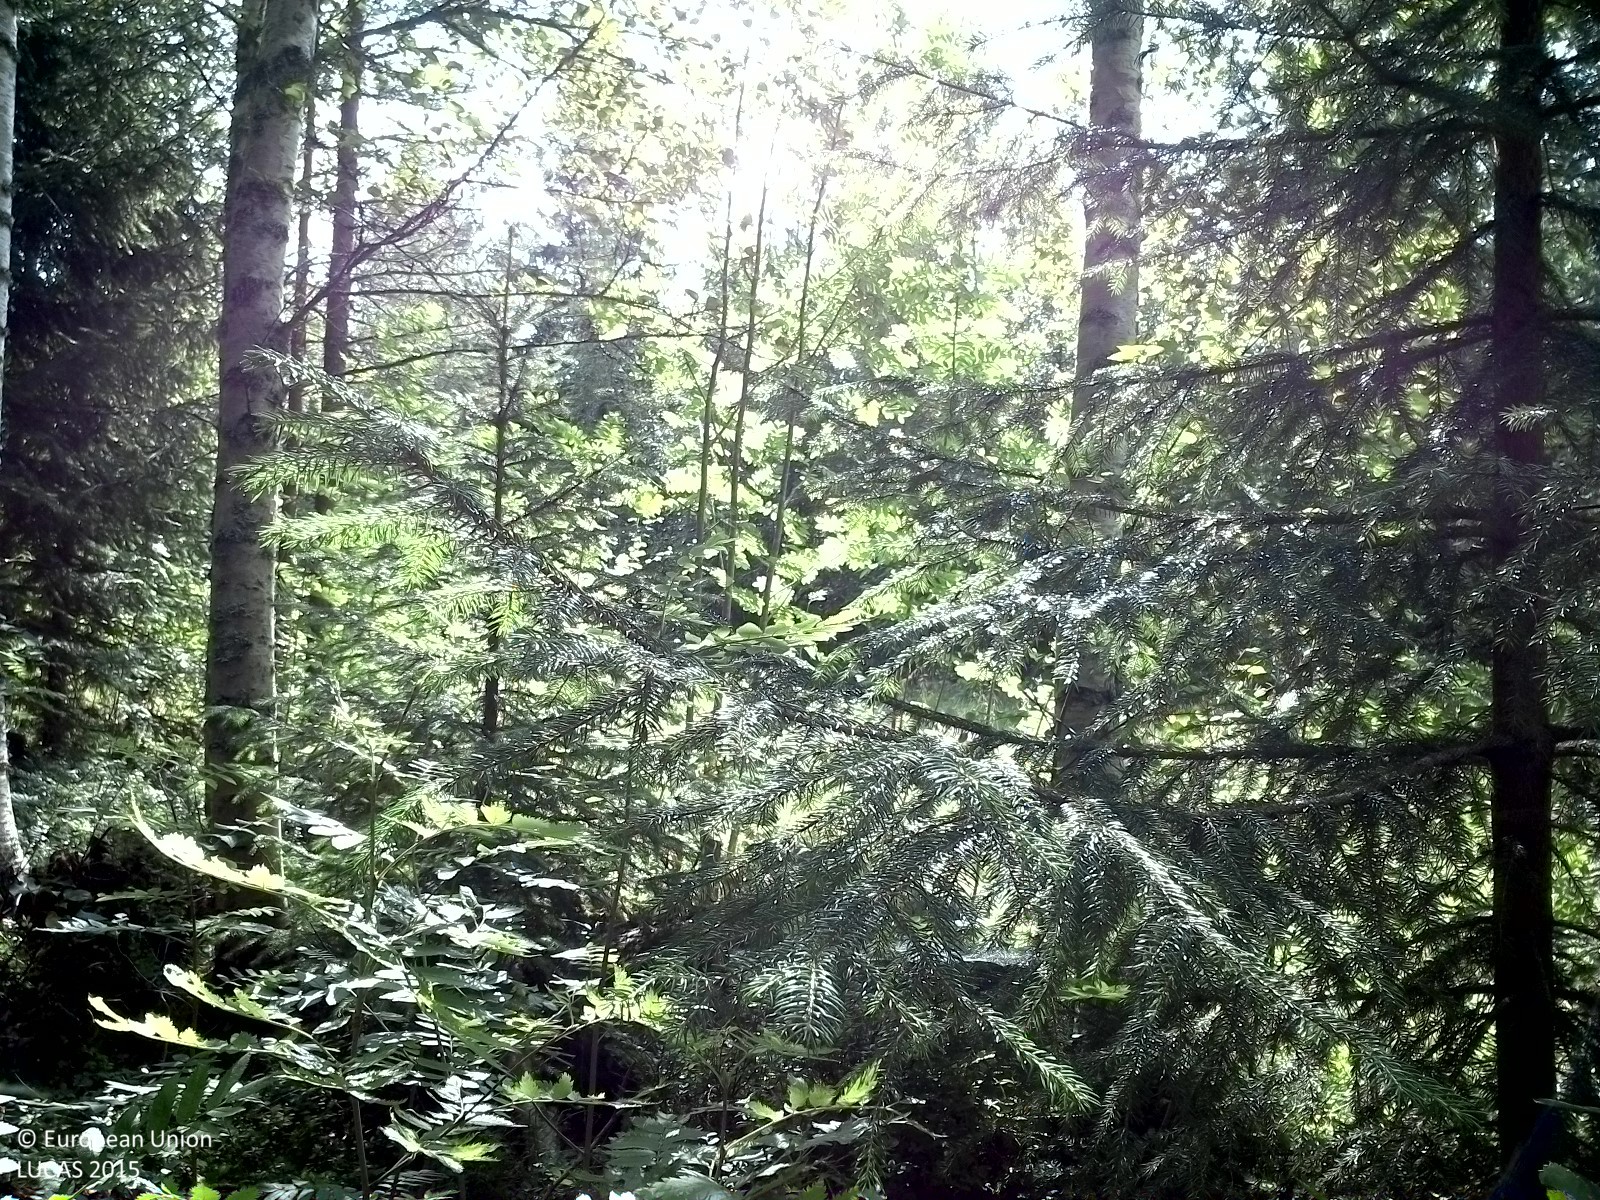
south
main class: Woodland
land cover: Spruce dominated mixed woodland
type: boreal forest
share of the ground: 50 - 75 %
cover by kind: broadleaved forest trees 50 %, coniferous forest trees 20 %, shrubs 15 %, herbaceous plants 15 %
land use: Sport
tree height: > 5 m
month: August
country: SE
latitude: 62.3823
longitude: 17.2703
